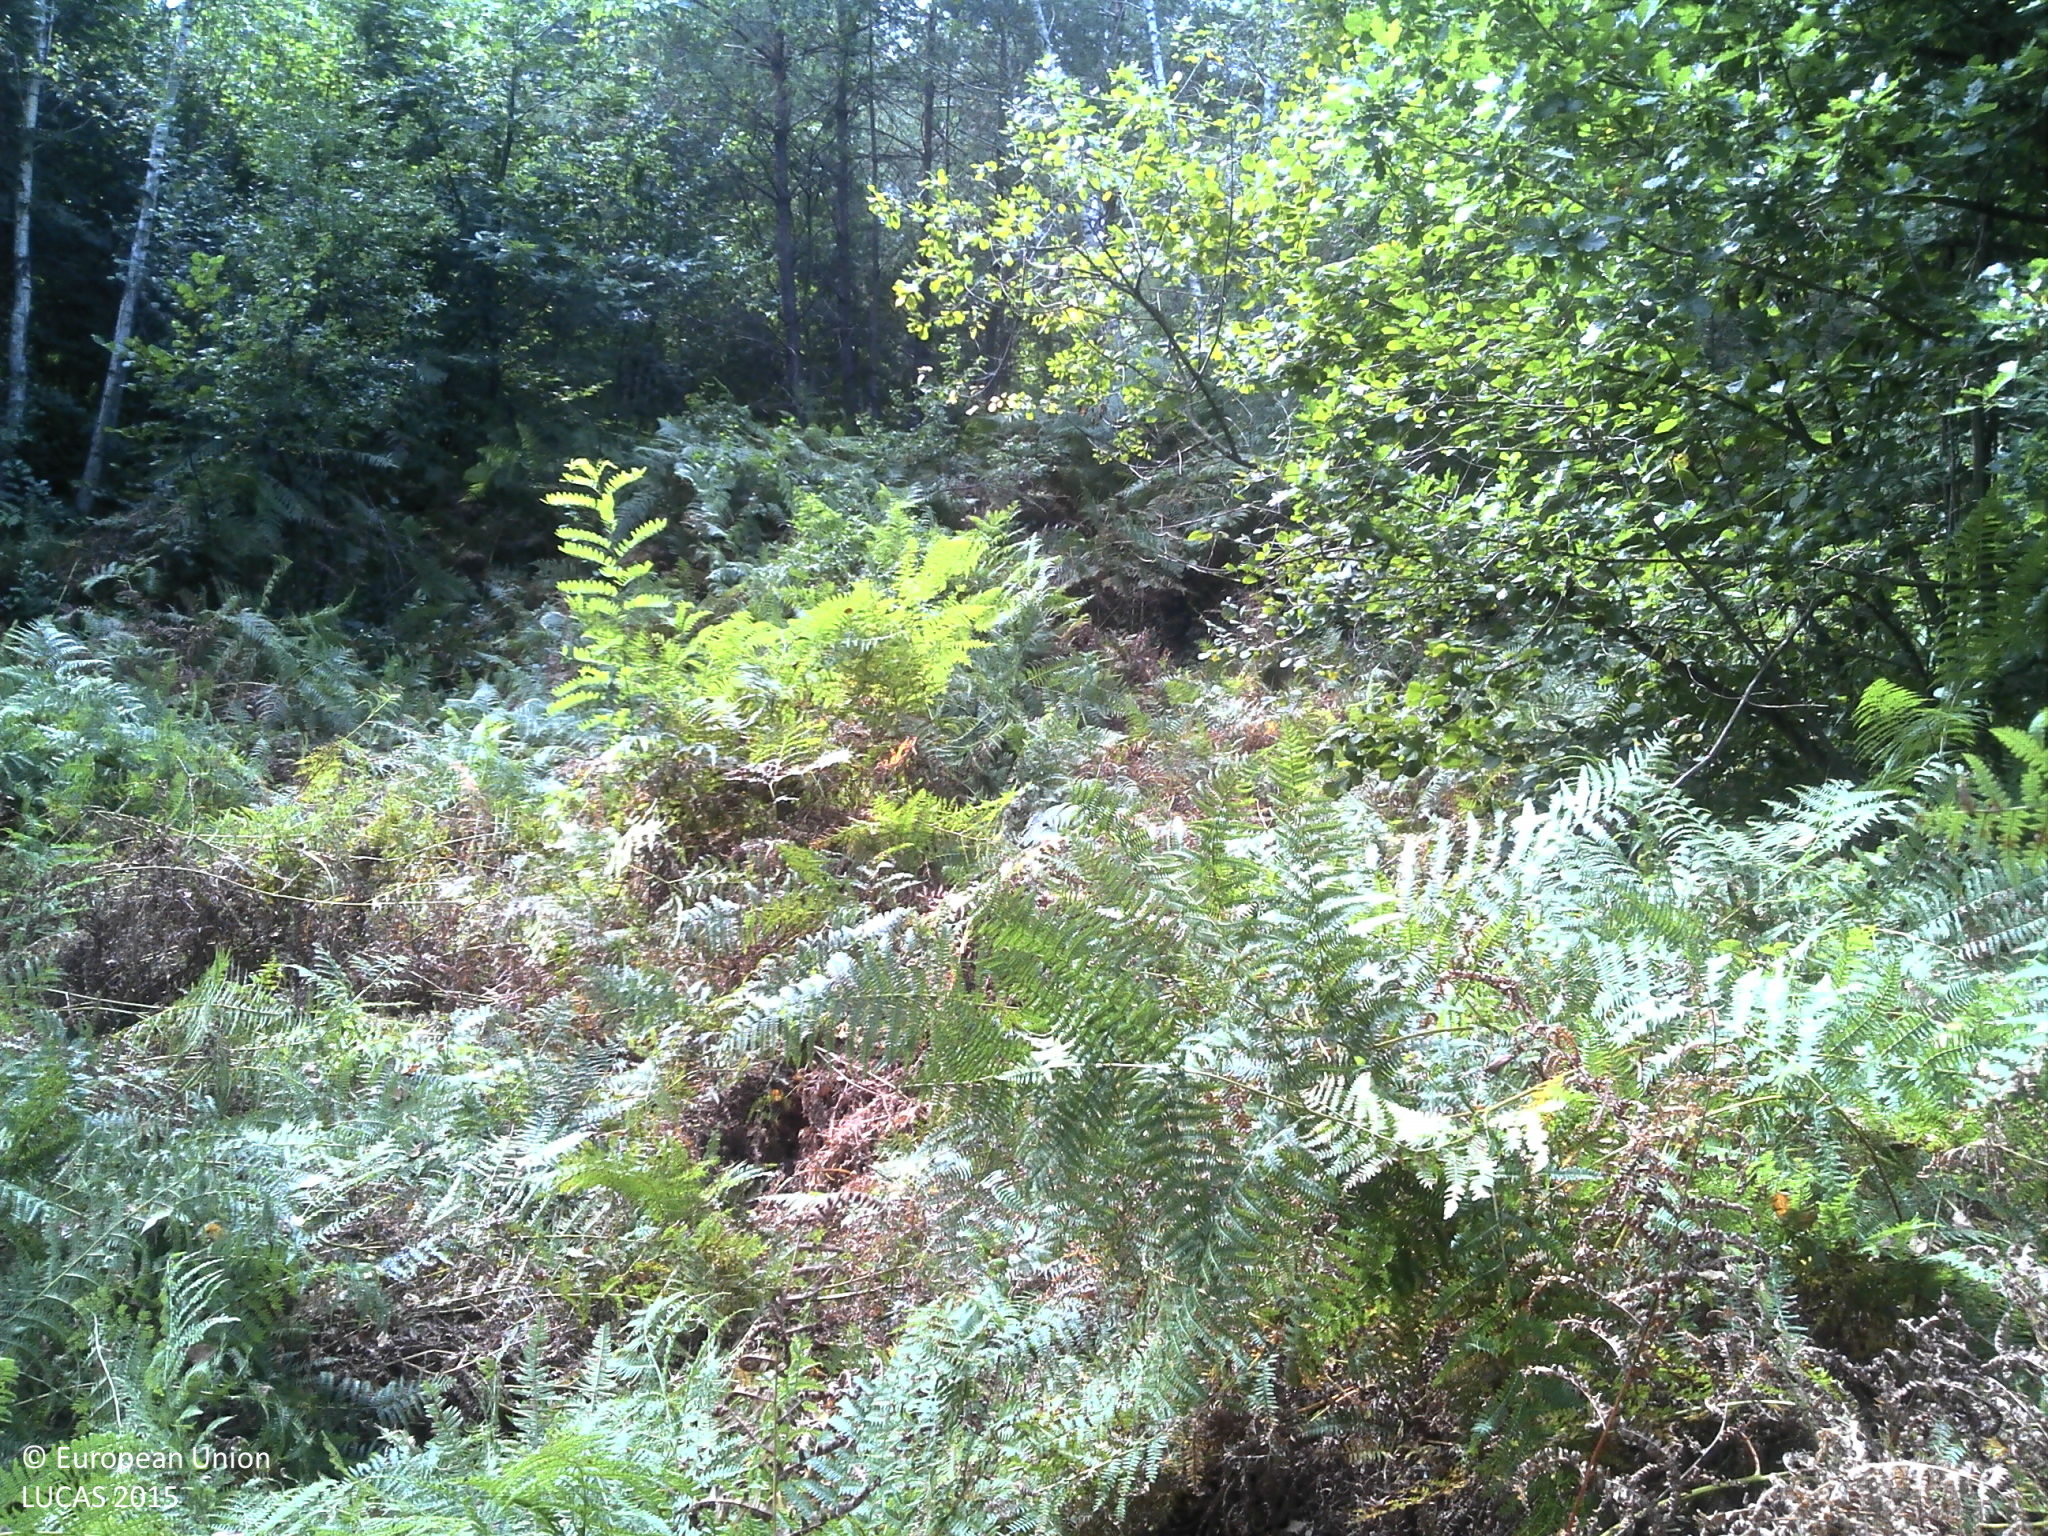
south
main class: Woodland
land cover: Broadleaved woodland
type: non-riverine alder, birch or aspen forest
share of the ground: > 75 %
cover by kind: broadleaved forest trees 100 %
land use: Forestry
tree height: > 5 m
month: September
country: HR
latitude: 45.4268
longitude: 15.2743
